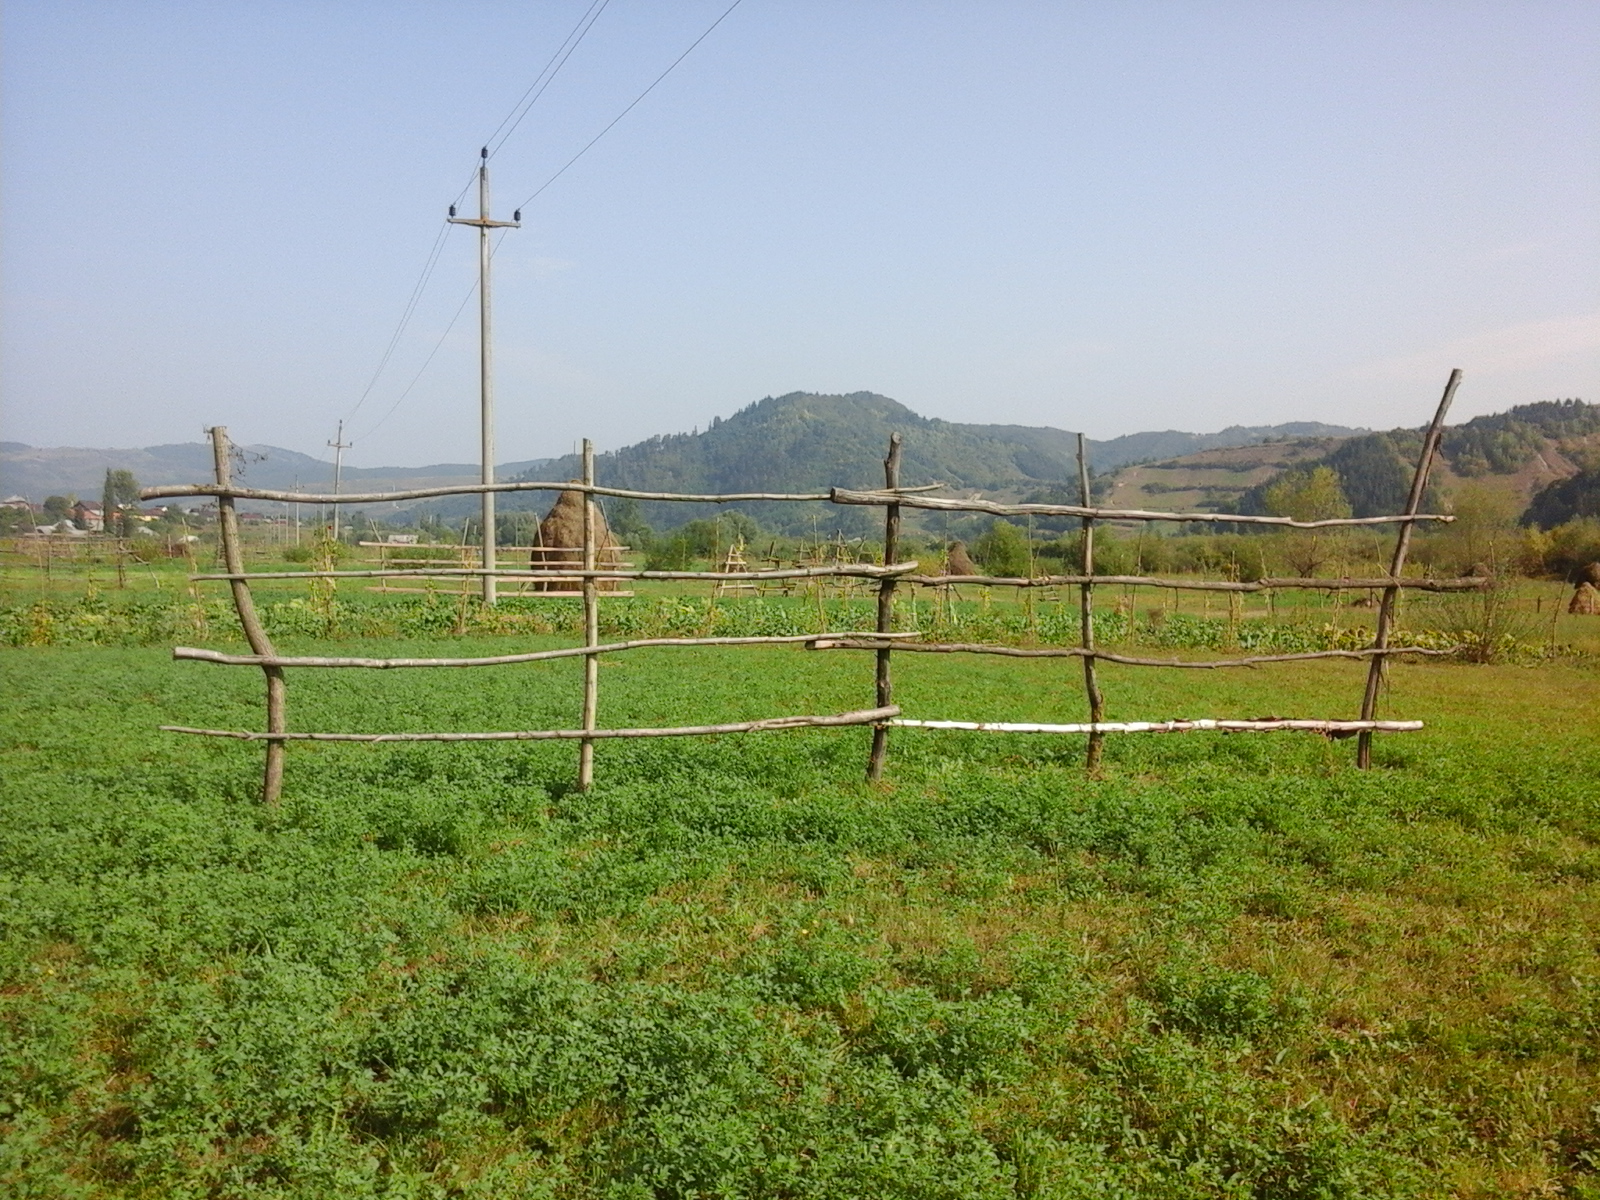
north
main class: Cropland
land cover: Lucerne
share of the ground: > 75 %
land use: Agriculture (excluding fallow land and kitchen gardens)
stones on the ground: < 10 %
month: September
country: RO
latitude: 47.7144
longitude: 24.2317
